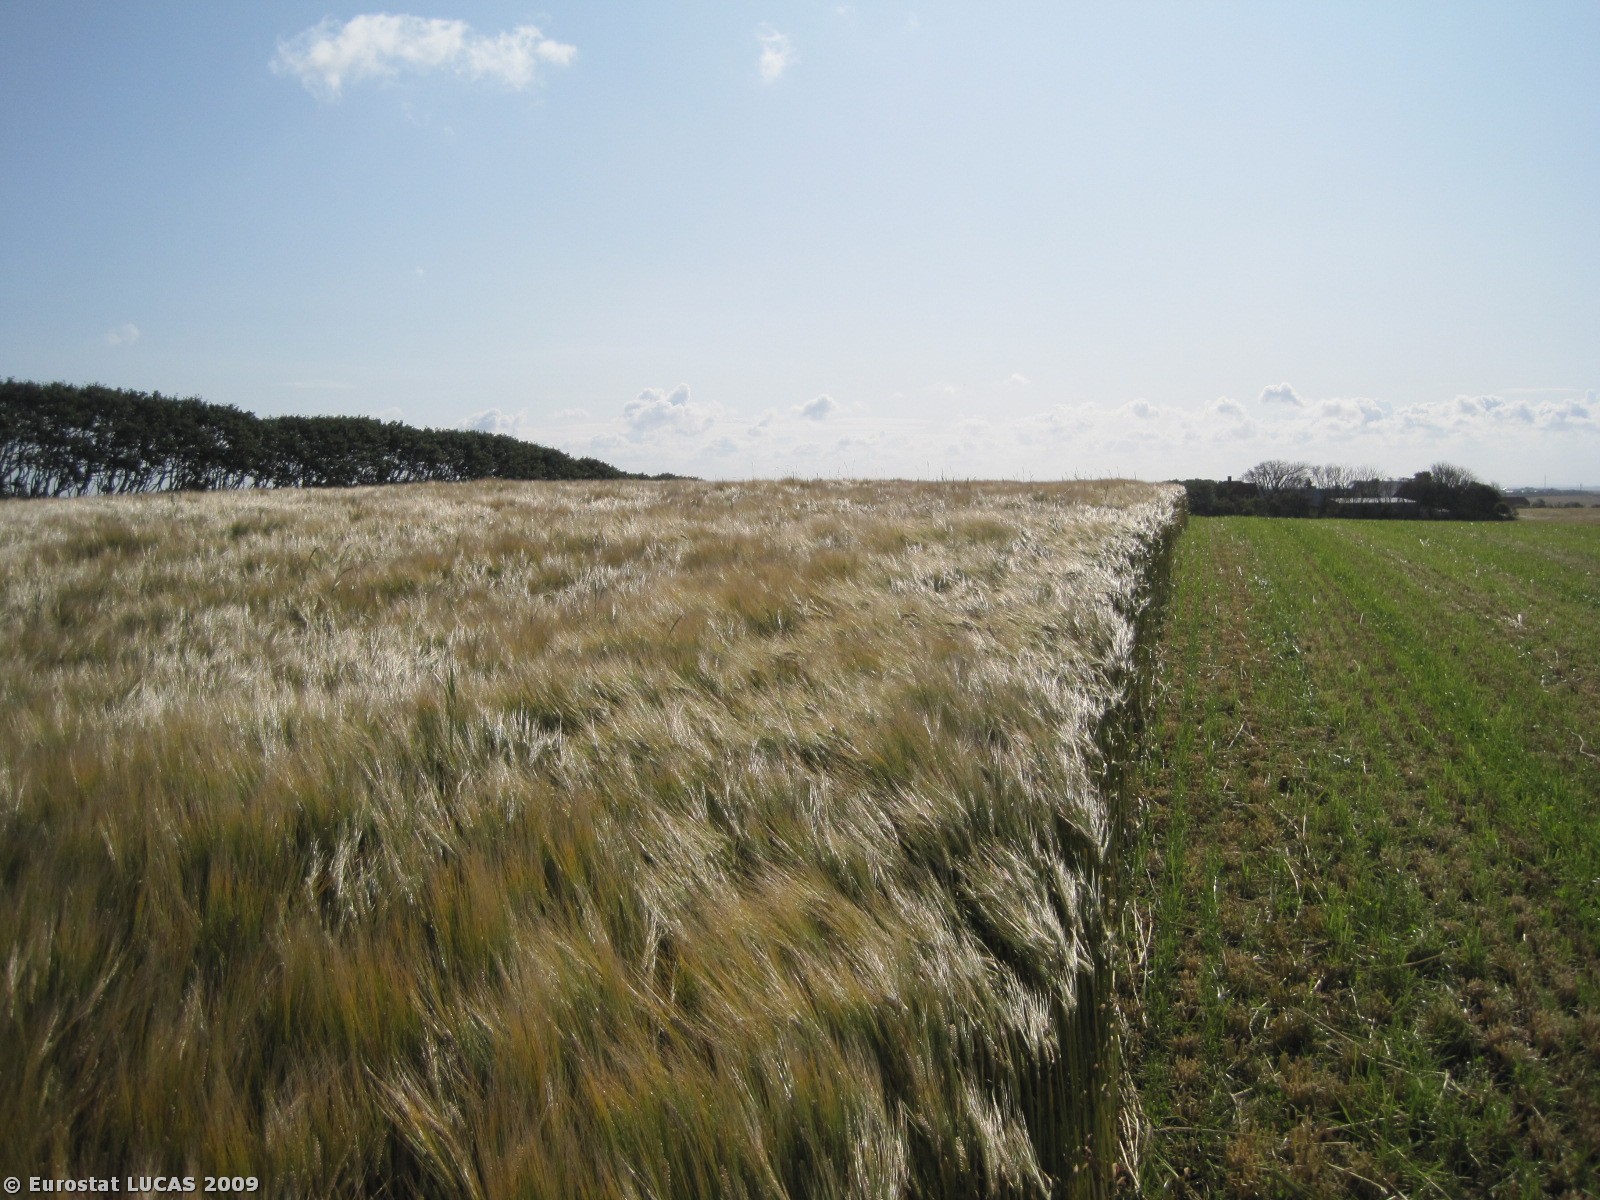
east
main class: Cropland
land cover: Barley
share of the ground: > 75 %
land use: Agriculture (excluding fallow land and kitchen gardens)
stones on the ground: < 10 %
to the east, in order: Barley; Grass margins; Broadleaved woodland; Grass margins; Common wheat; Grass margins; Broadleaved woodland; Grass margins; Barley
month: July
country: DK
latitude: 56.7166
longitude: 8.3519
